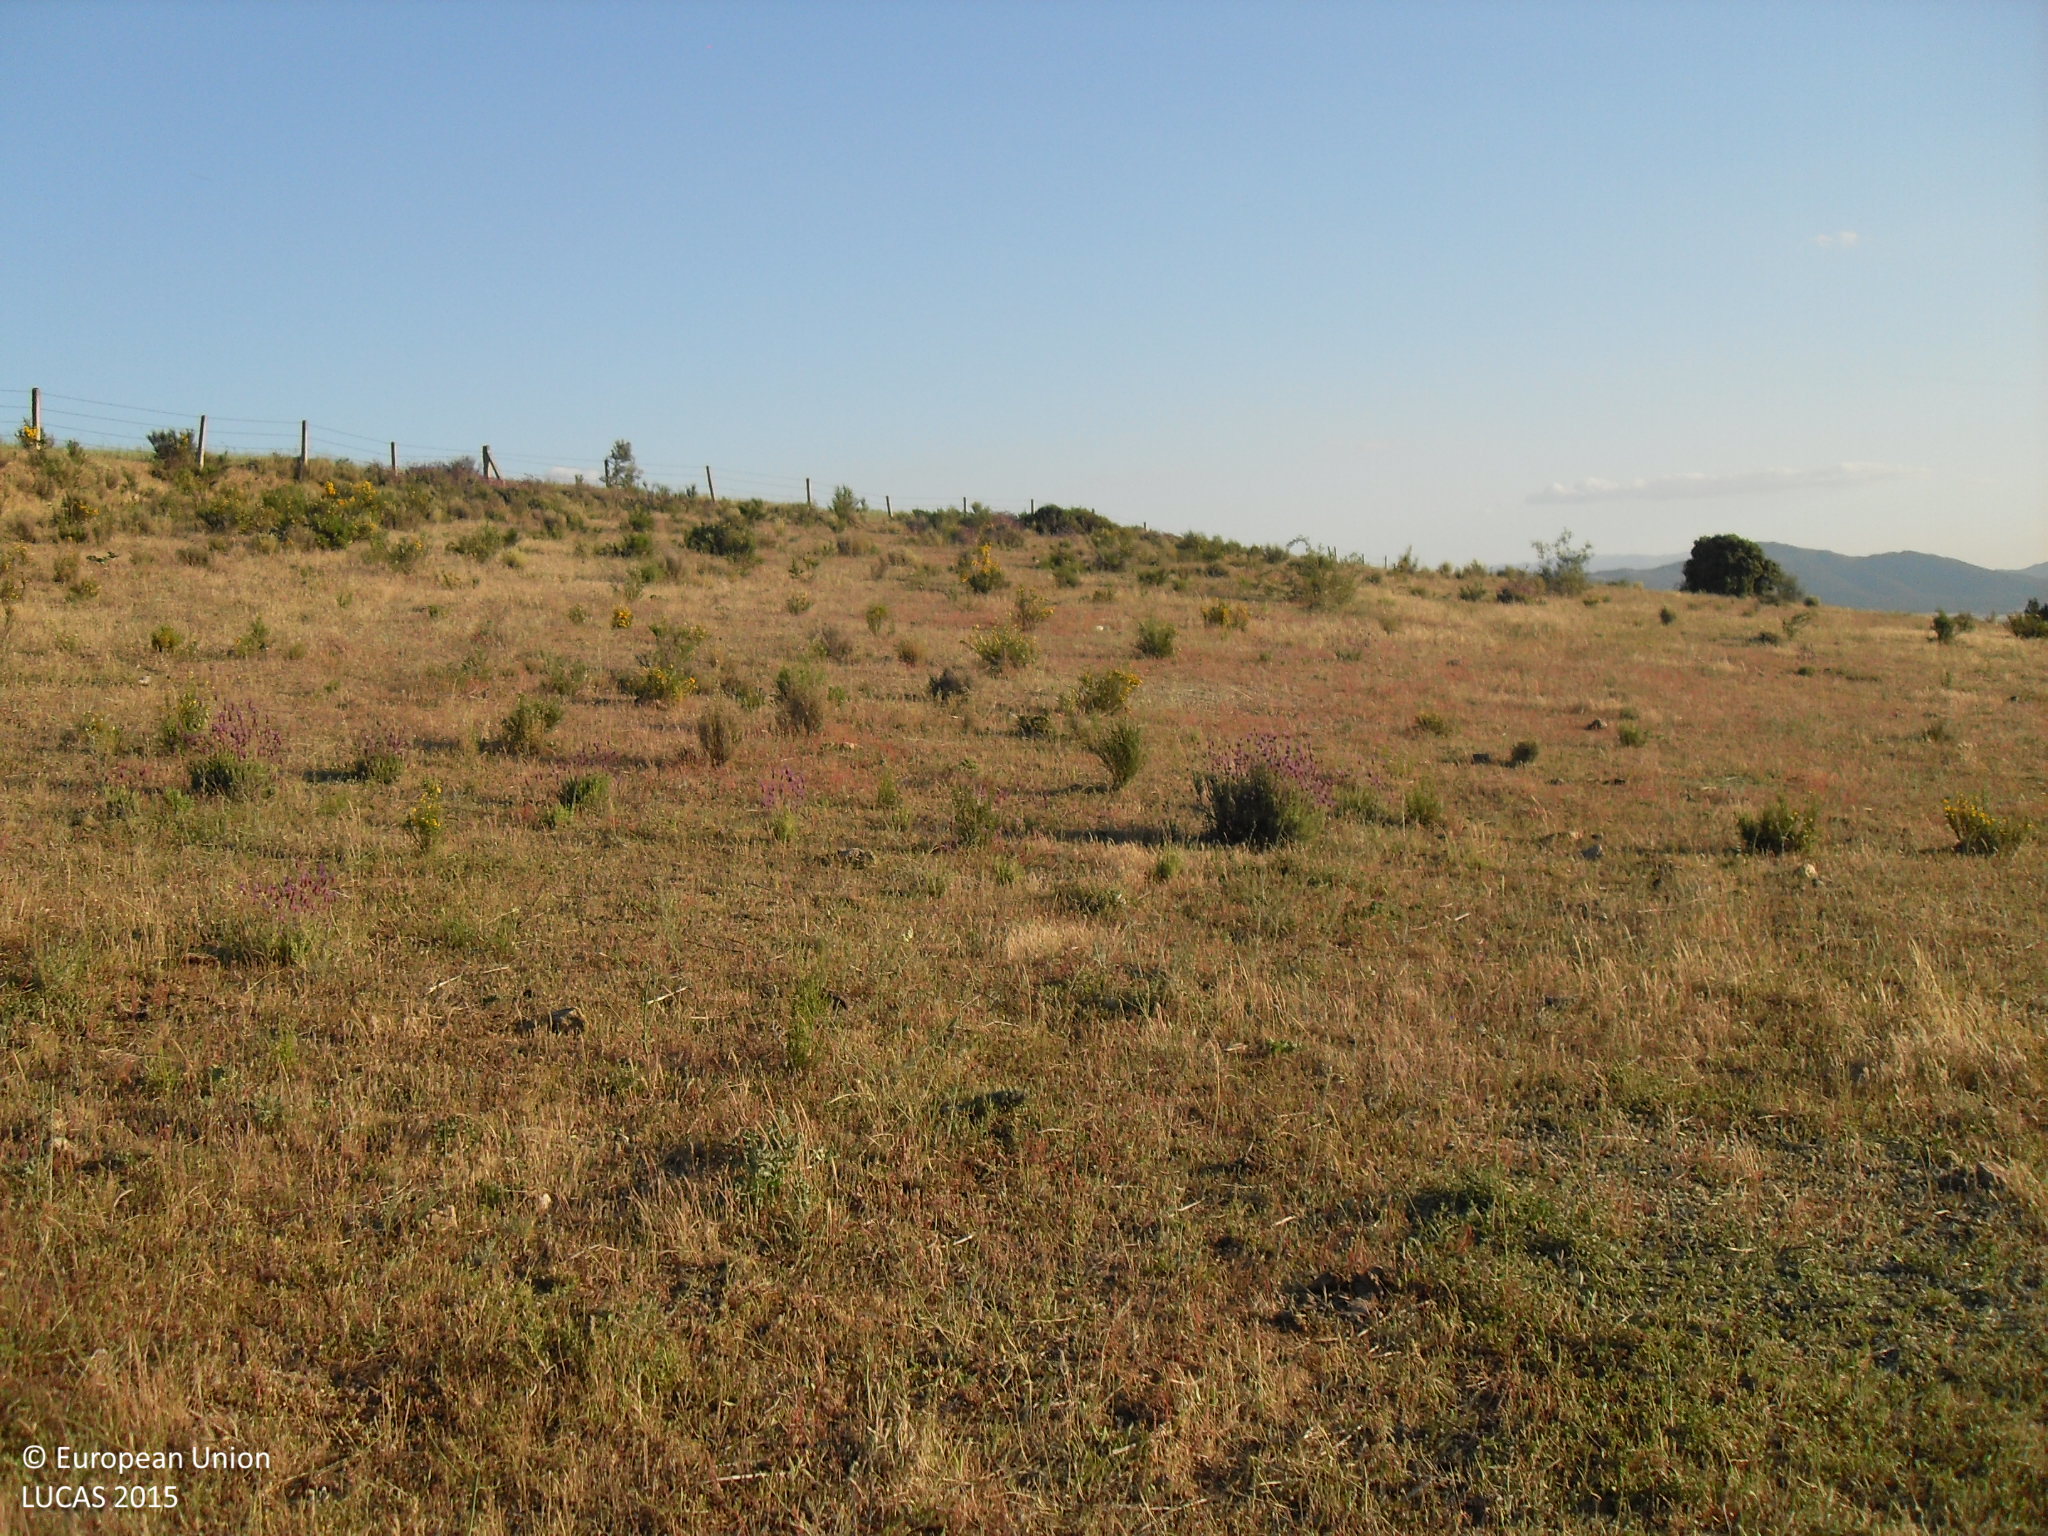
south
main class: Grassland
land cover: Grassland without tree/shrub cover
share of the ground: > 75 %
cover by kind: herbaceous plants 100 %
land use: Agriculture (excluding fallow land and kitchen gardens)
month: May
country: ES
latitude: 40.5534
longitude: -5.2621
